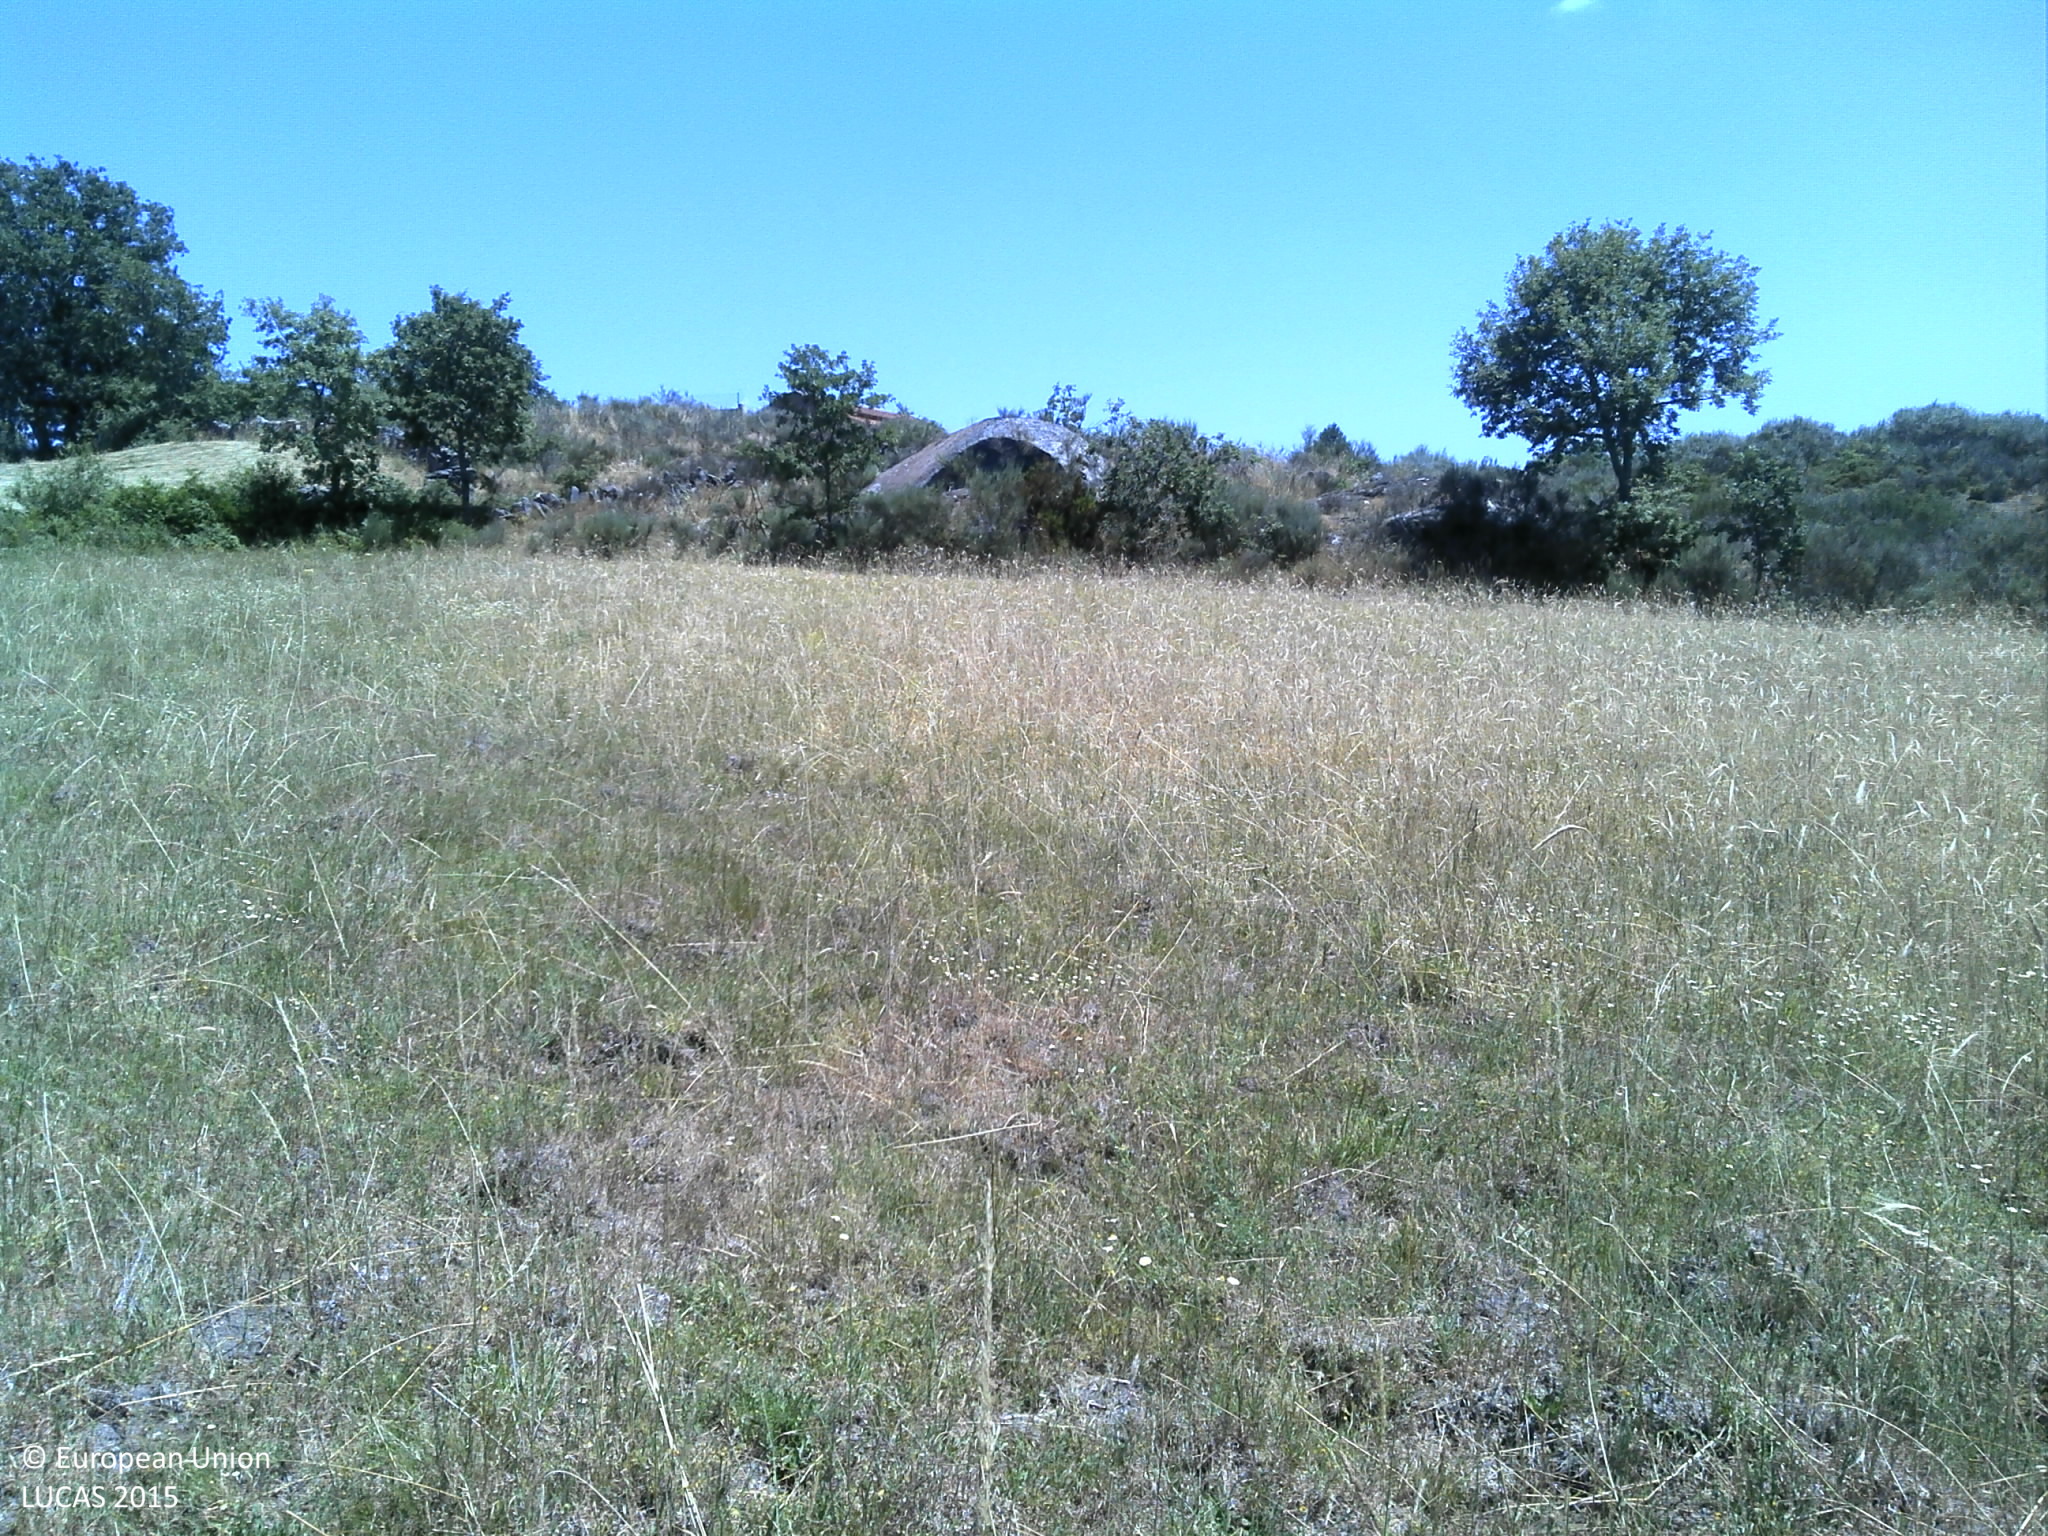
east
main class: Grassland
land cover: Grassland without tree/shrub cover
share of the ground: > 75 %
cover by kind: herbaceous plants 95 %, unconsolidated bare surface 5 %
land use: Agriculture (excluding fallow land and kitchen gardens)
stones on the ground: < 10 %
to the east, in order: Grassland without tree/shrub cover; Shrubland without tree cover; Rocks and stones; Shrubland without tree cover; Dry stone walls; Shrubland without tree cover; Artificial constructions in urban areas; Shrubland without tree cover; Dry stone walls; Shrubland without tree cover; Grassland without tree/shrub cover
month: July
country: PT
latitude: 41.8089
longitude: -7.6496
